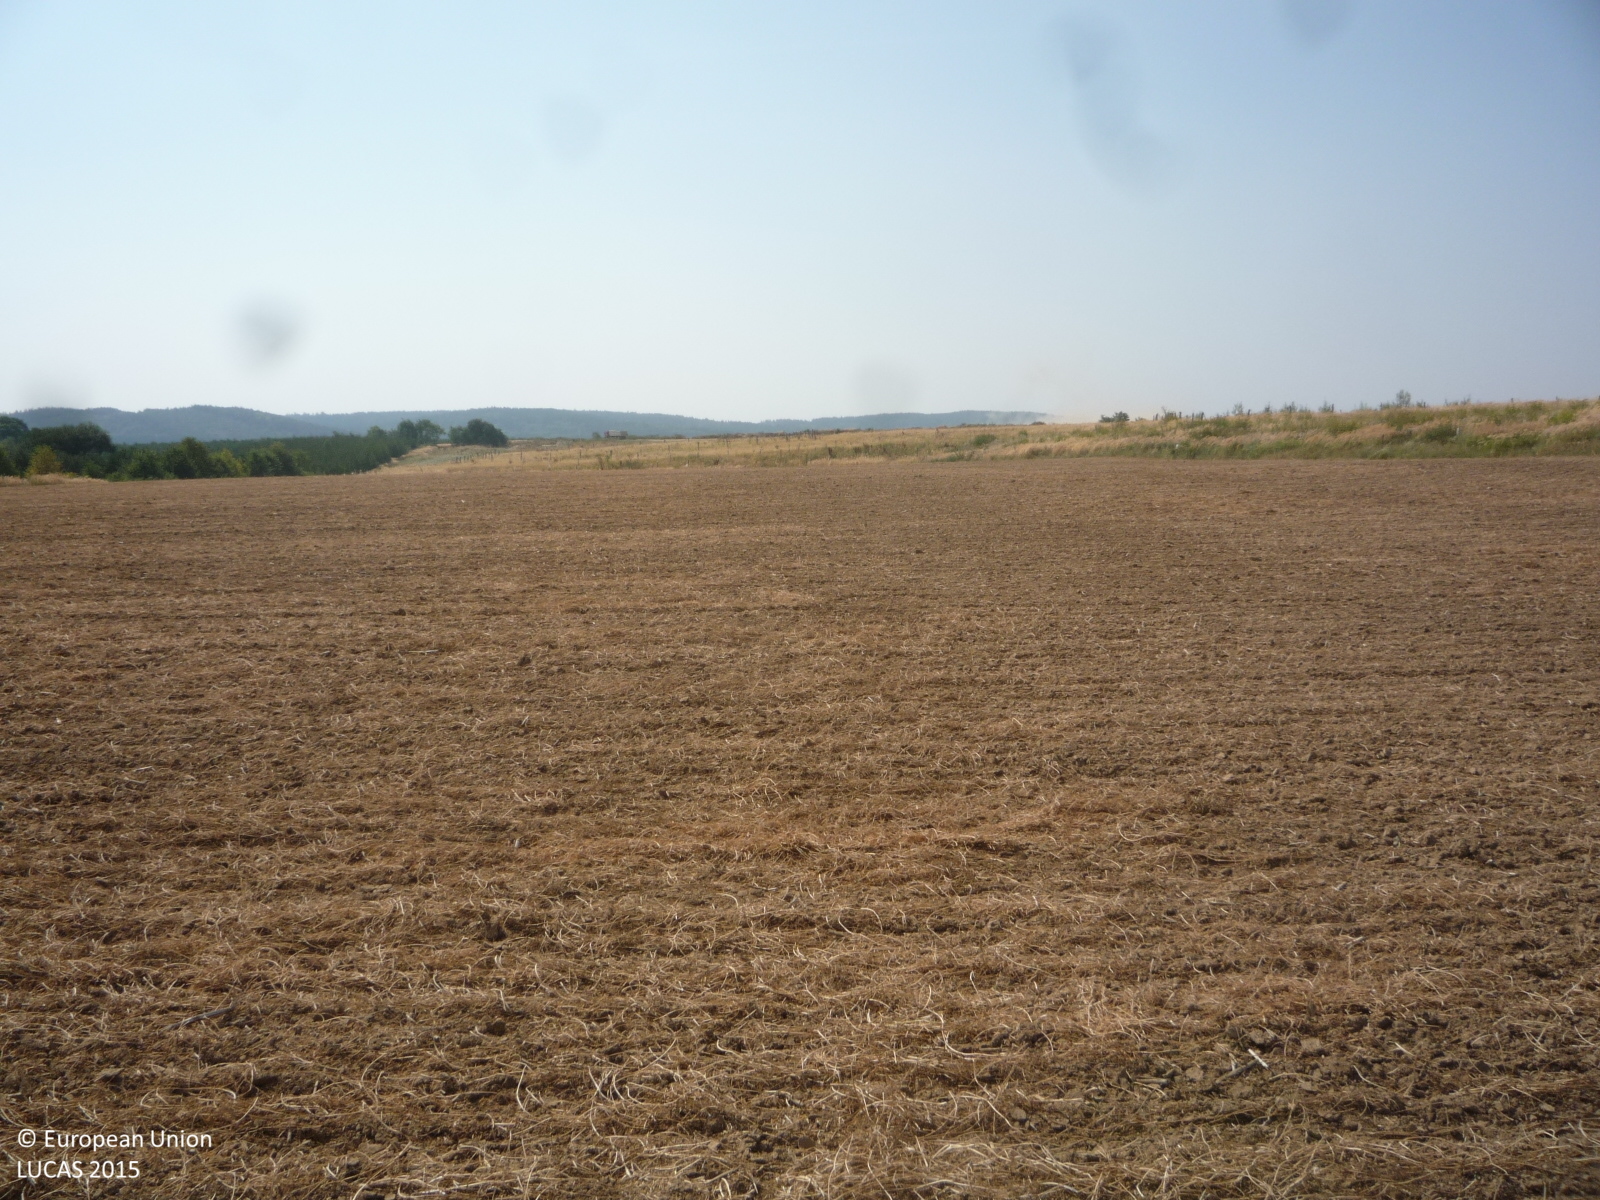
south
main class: Cropland
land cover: Dry pulses
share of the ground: < 10 %
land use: Agriculture (excluding fallow land and kitchen gardens)
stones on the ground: < 10 %
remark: Harvested field
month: August
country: CZ
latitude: 49.9512
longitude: 14.5033
